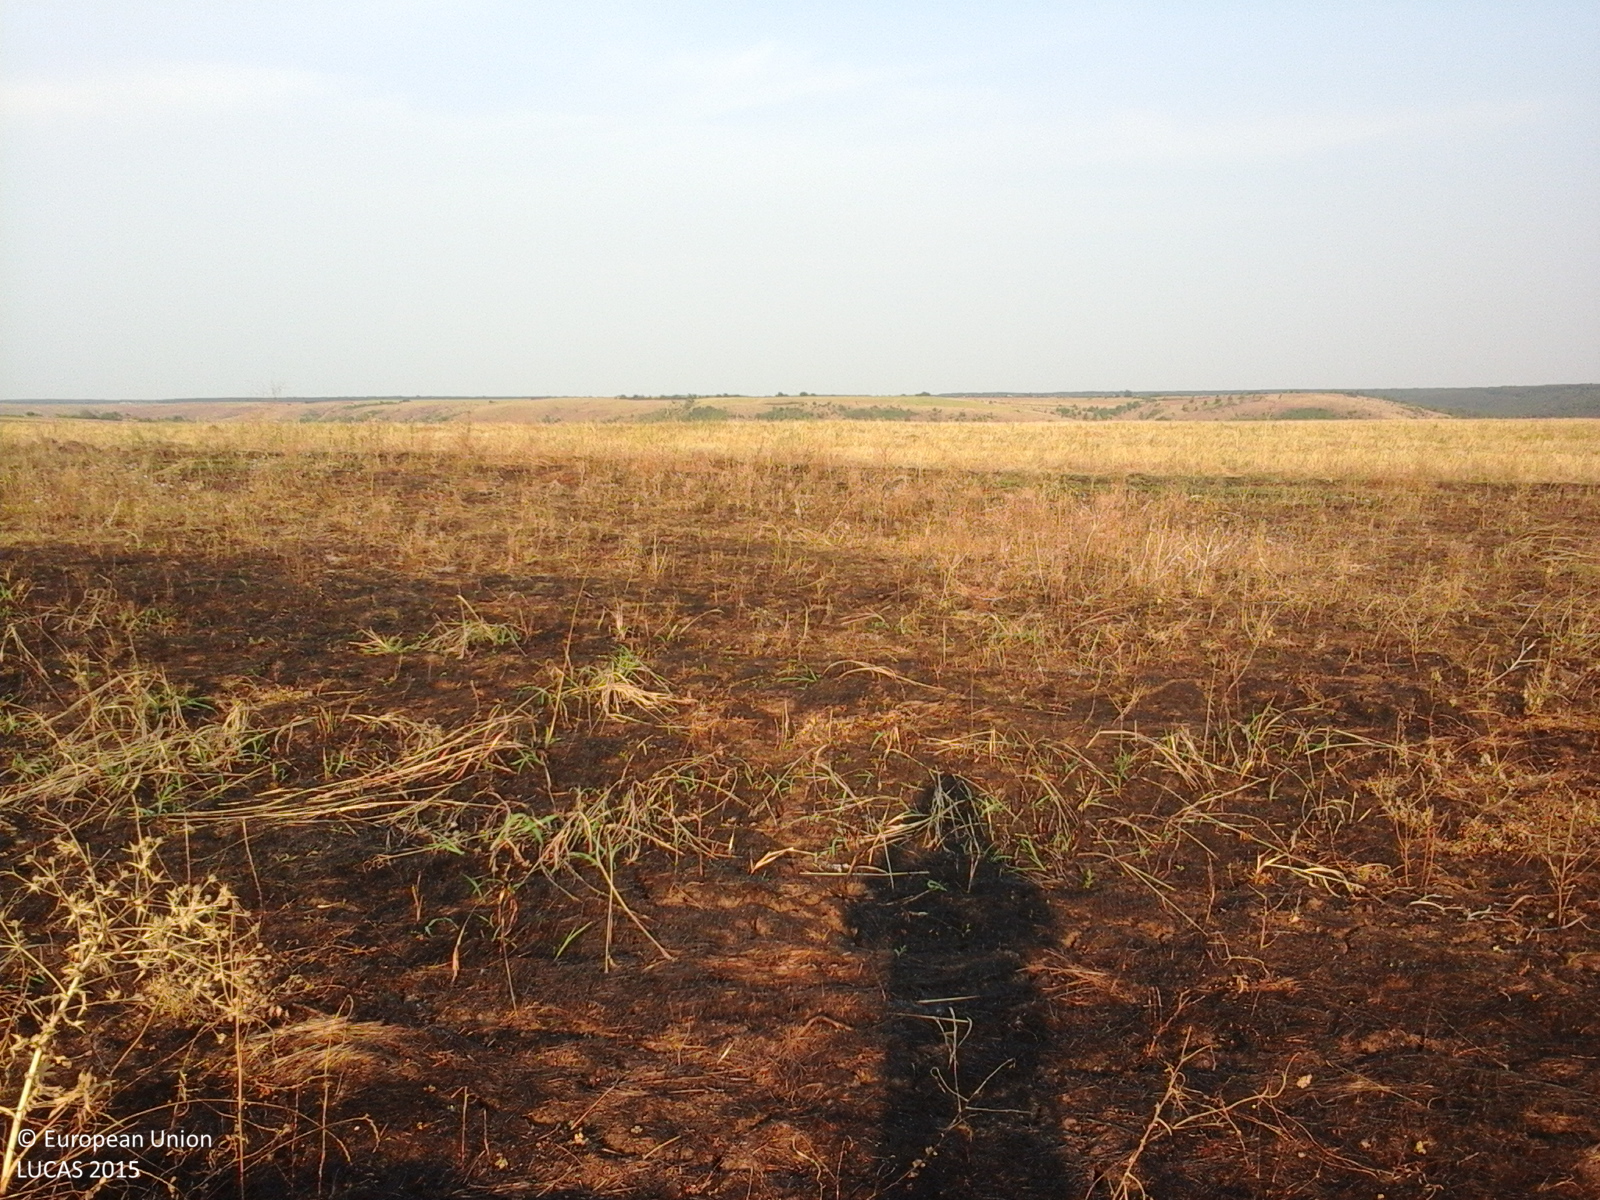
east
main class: Grassland
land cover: Spontaneously vegetated surfaces
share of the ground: > 75 %
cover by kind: herbaceous plants 100 %
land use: Fallow land
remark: Burnt area
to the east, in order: Spontaneously vegetated surfaces; Common wheat; Spontaneously vegetated surfaces
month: August
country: RO
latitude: 44.2553
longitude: 23.5920
